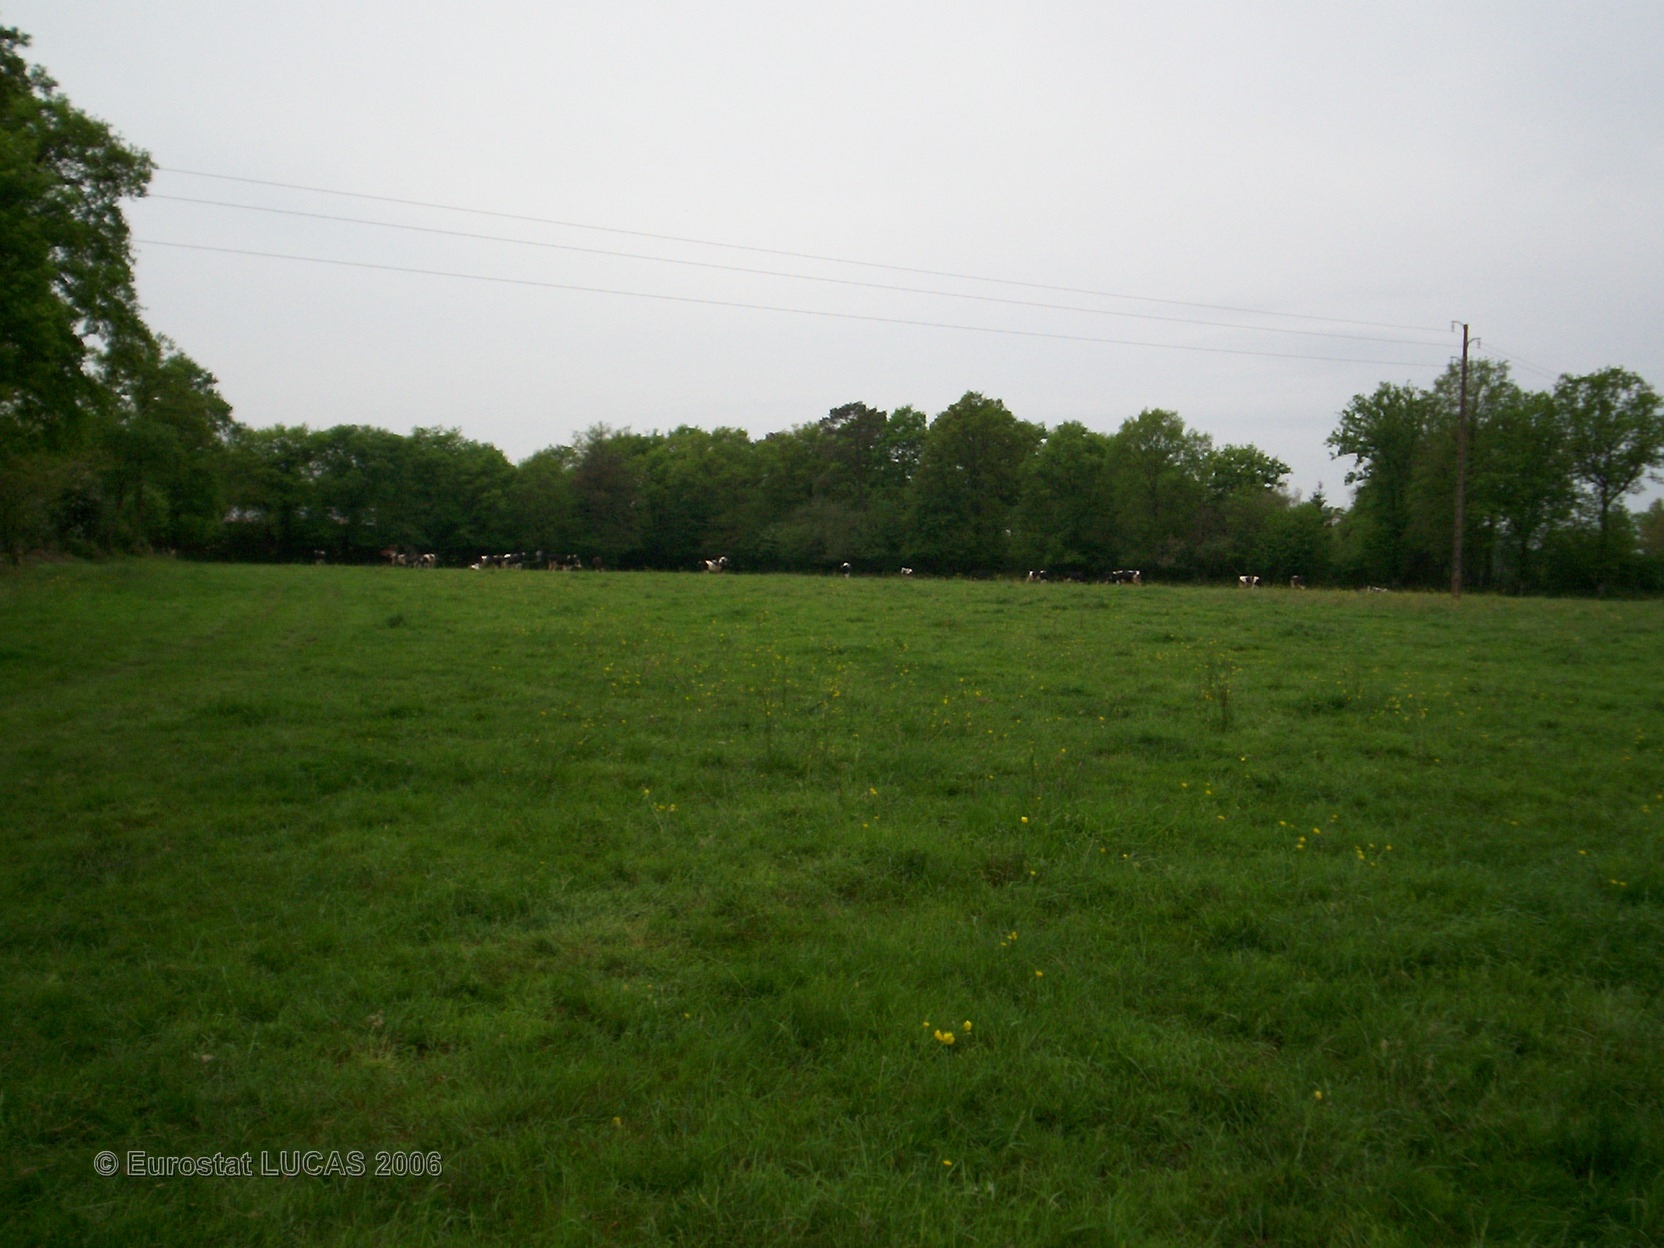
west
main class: Grassland
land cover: Grassland without tree/shrub cover
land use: Agriculture (excluding fallow land and kitchen gardens)
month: May
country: FR
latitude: 48.2938
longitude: -1.6540
